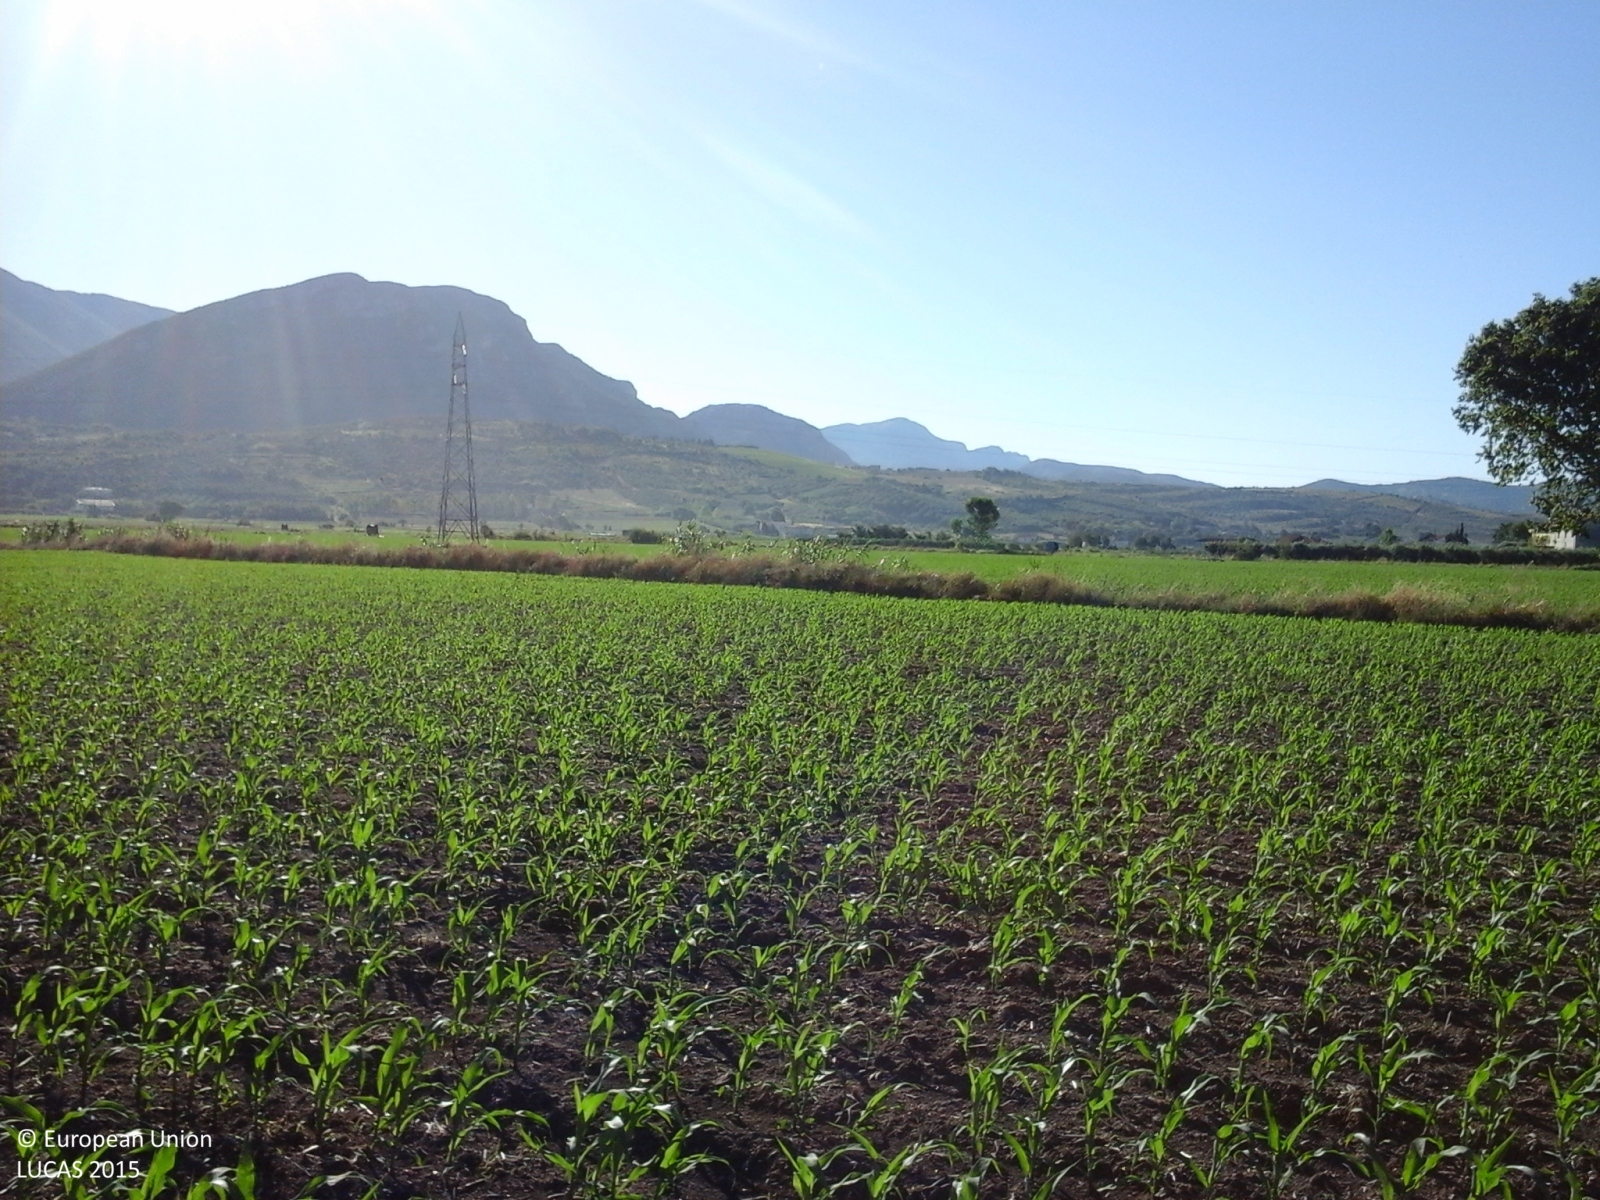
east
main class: Cropland
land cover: Maize
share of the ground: 25 - 50 %
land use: Agriculture (excluding fallow land and kitchen gardens)
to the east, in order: Maize; Grass margins; Ditches and canals; Grass margins; Maize; Electric lines; Maize
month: June
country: IT
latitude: 40.4100
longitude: 15.0336
